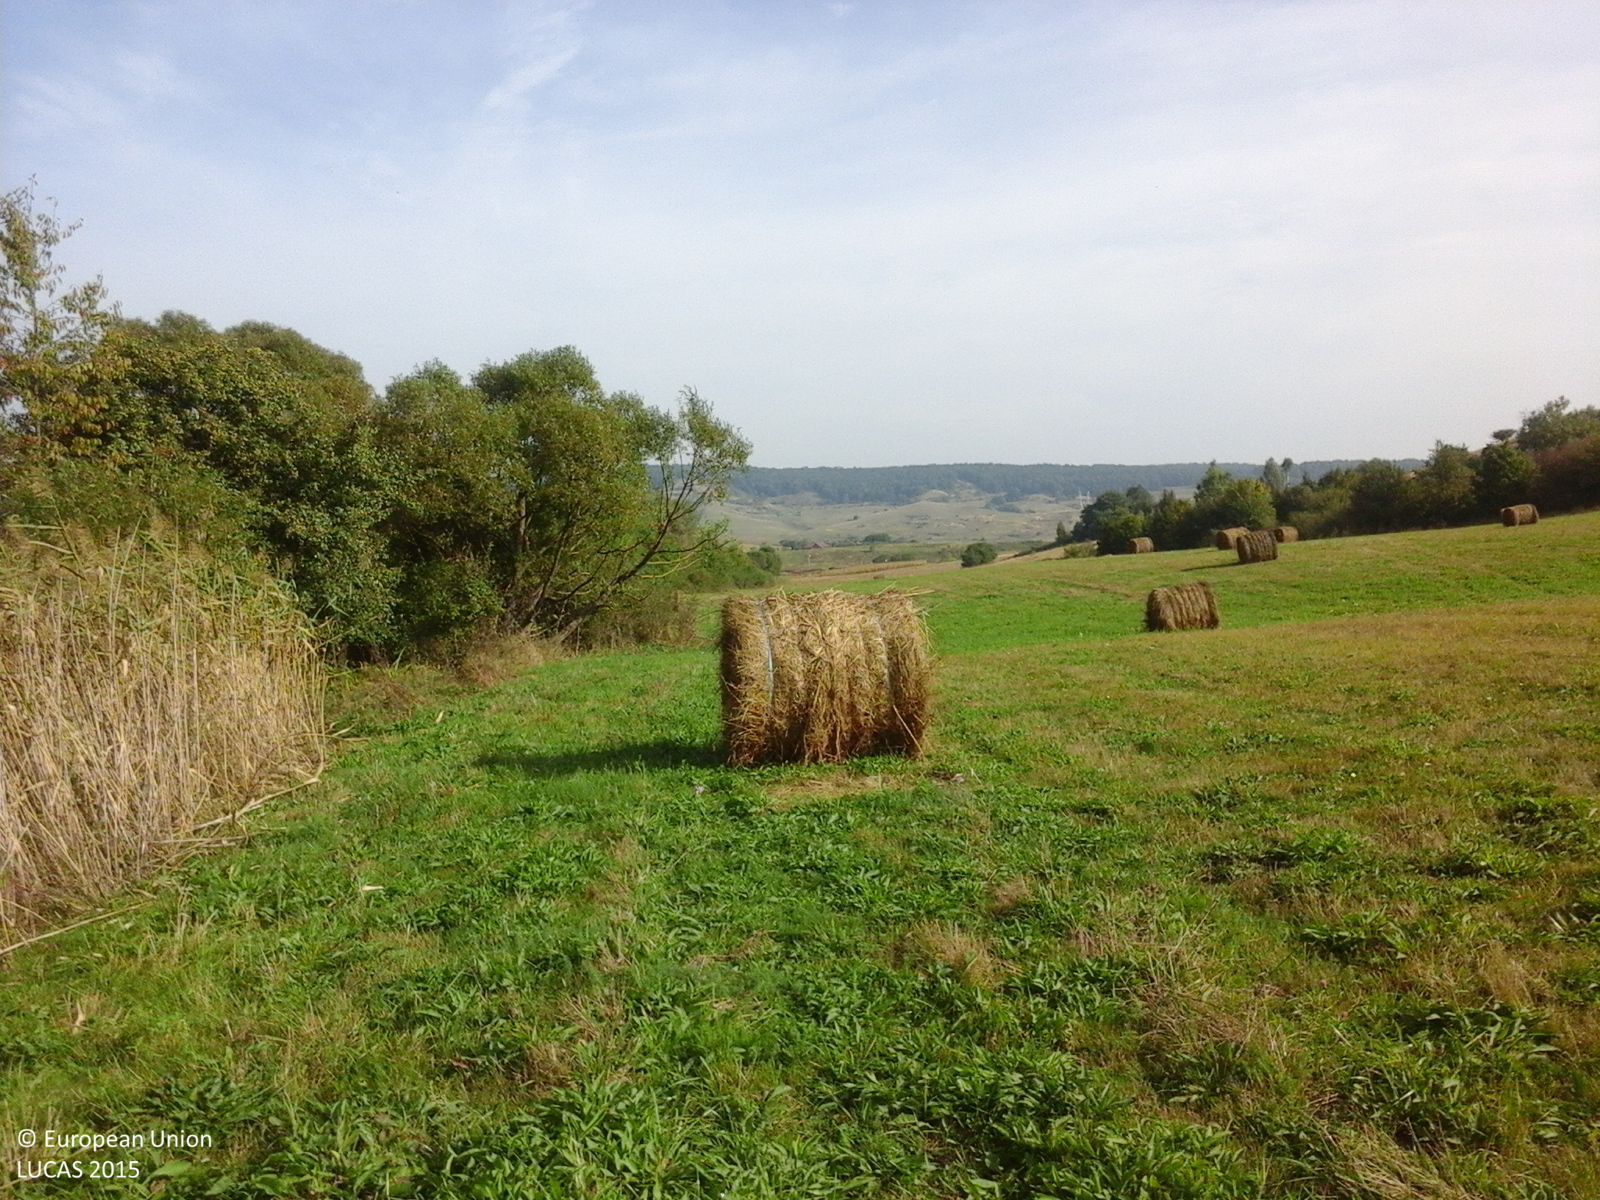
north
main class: Grassland
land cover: Grassland without tree/shrub cover
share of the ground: > 75 %
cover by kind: herbaceous plants 100 %
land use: Agriculture (excluding fallow land and kitchen gardens)
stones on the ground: < 10 %
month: September
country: RO
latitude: 46.8817
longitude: 23.4673
